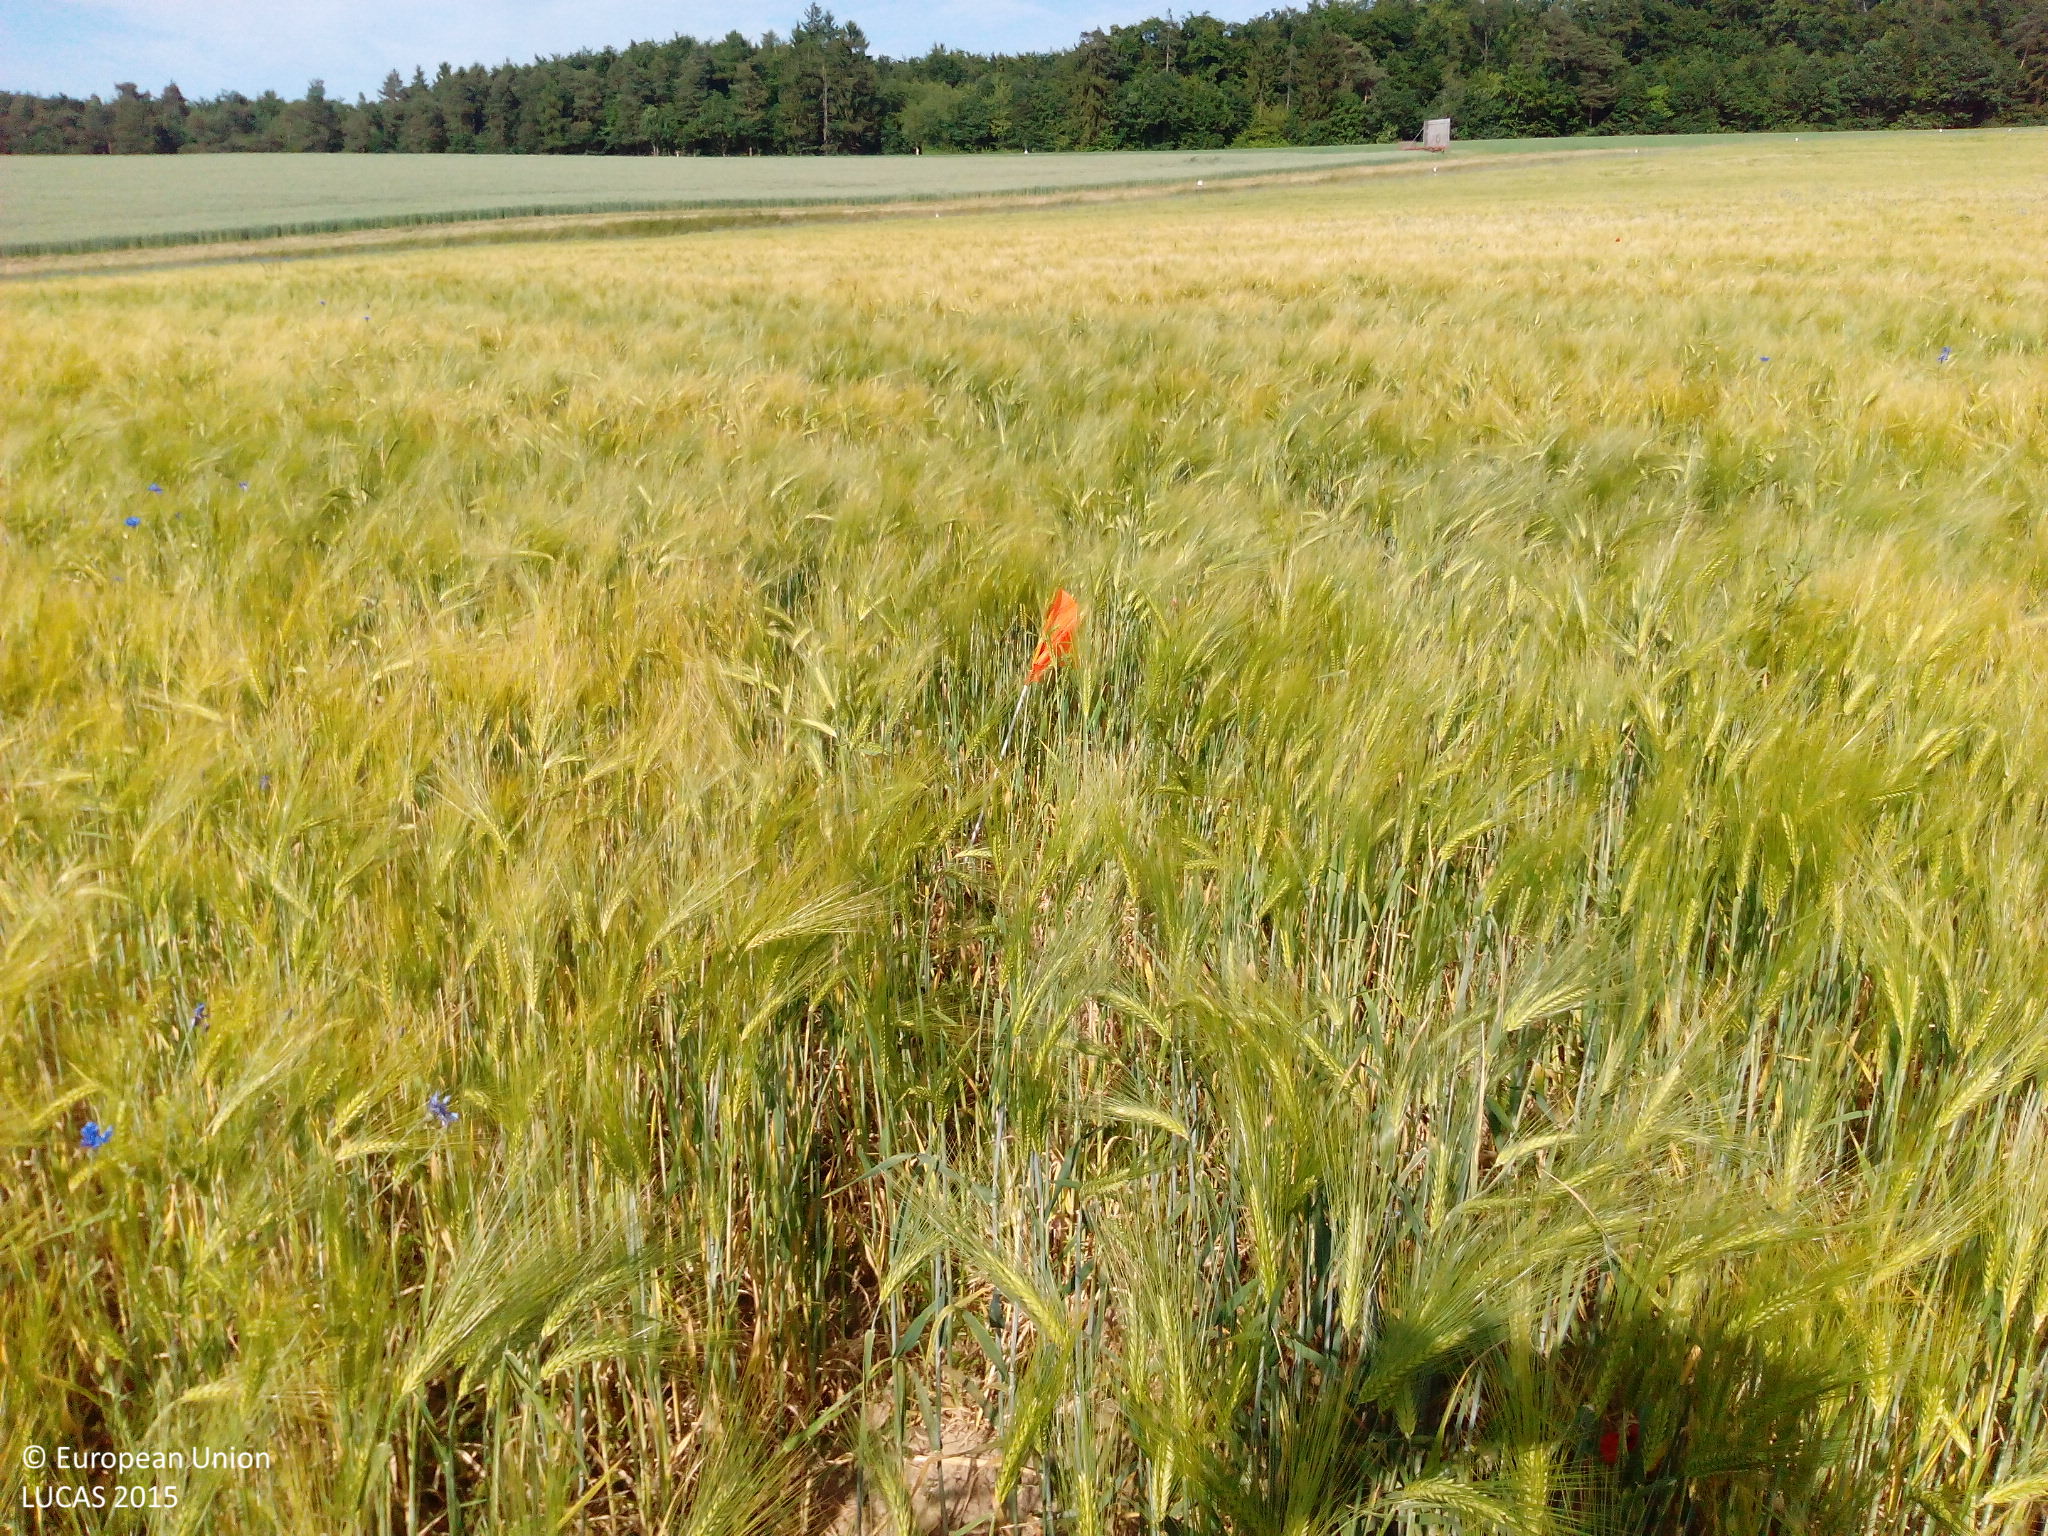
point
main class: Cropland
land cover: Barley
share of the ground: > 75 %
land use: Agriculture (excluding fallow land and kitchen gardens)
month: June
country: DE
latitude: 50.1870
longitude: 8.1376
